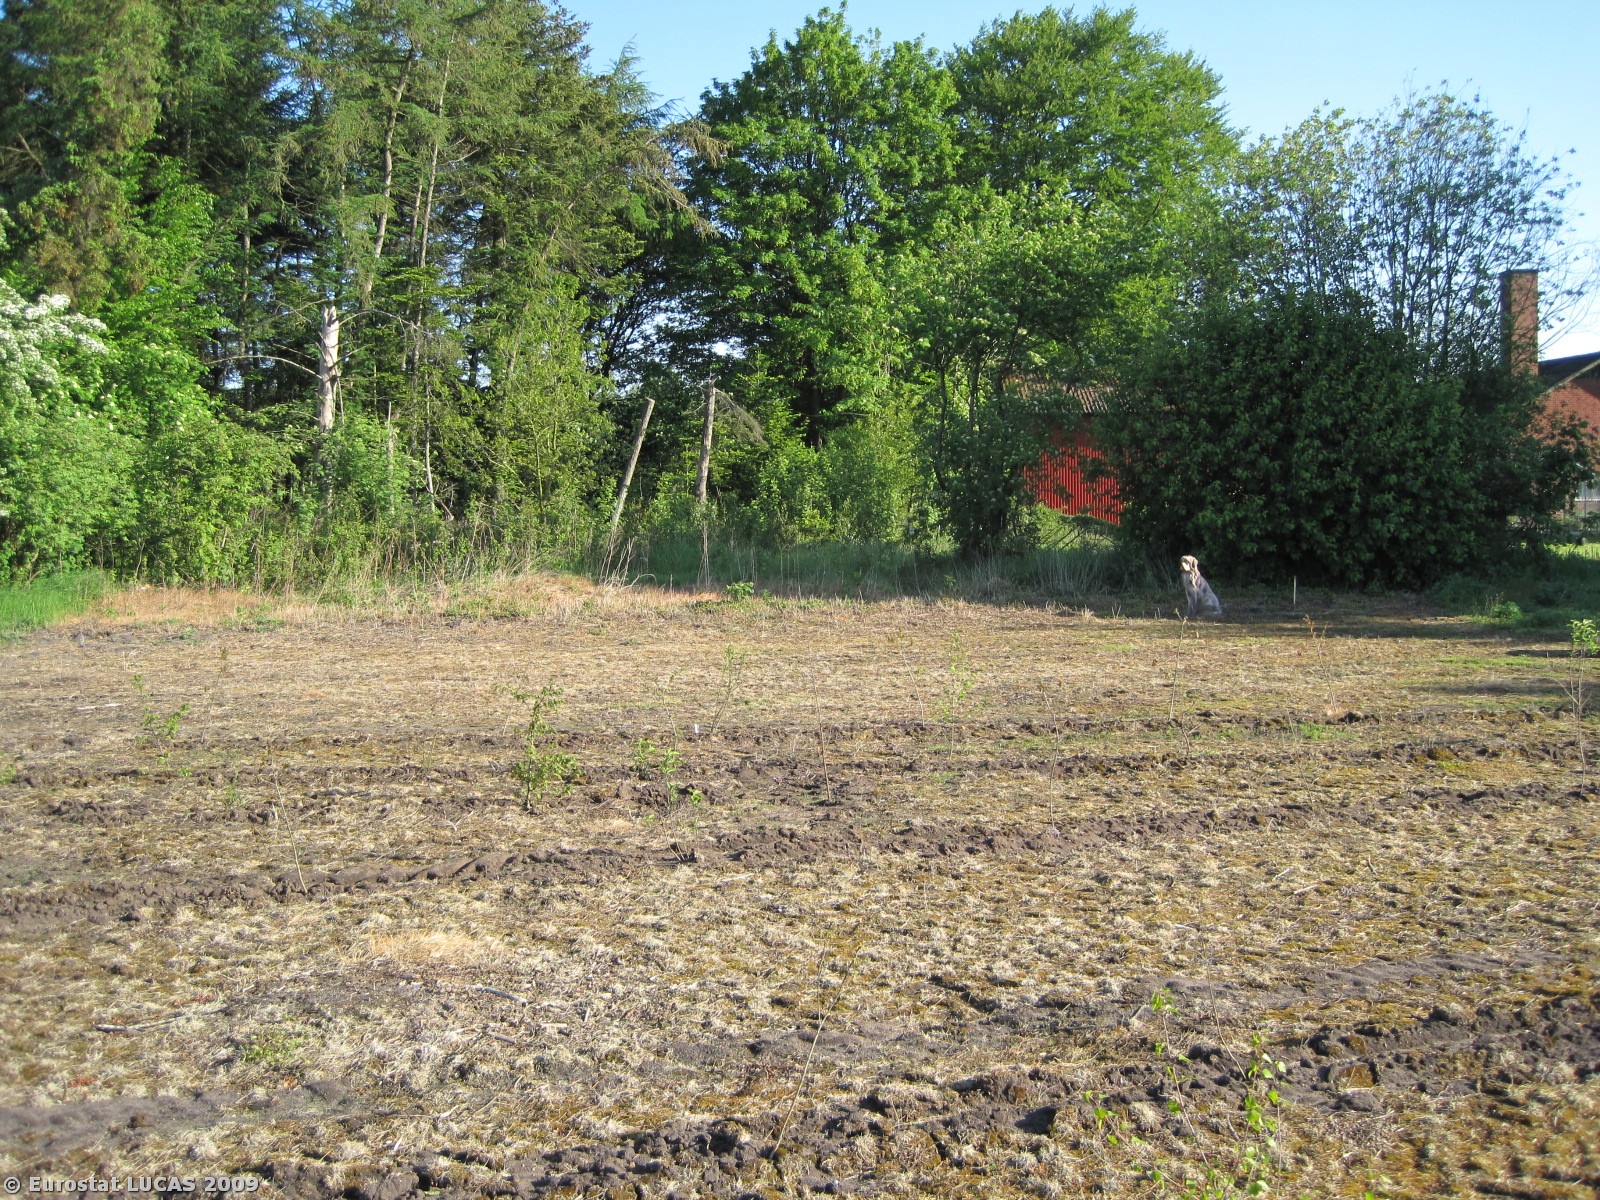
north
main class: Woodland
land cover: Broadleaved woodland
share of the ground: < 10 %
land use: Agriculture (excluding fallow land and kitchen gardens)
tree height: < 5 m
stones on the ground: < 10 %
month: May
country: DK
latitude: 56.4012
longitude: 9.2394
